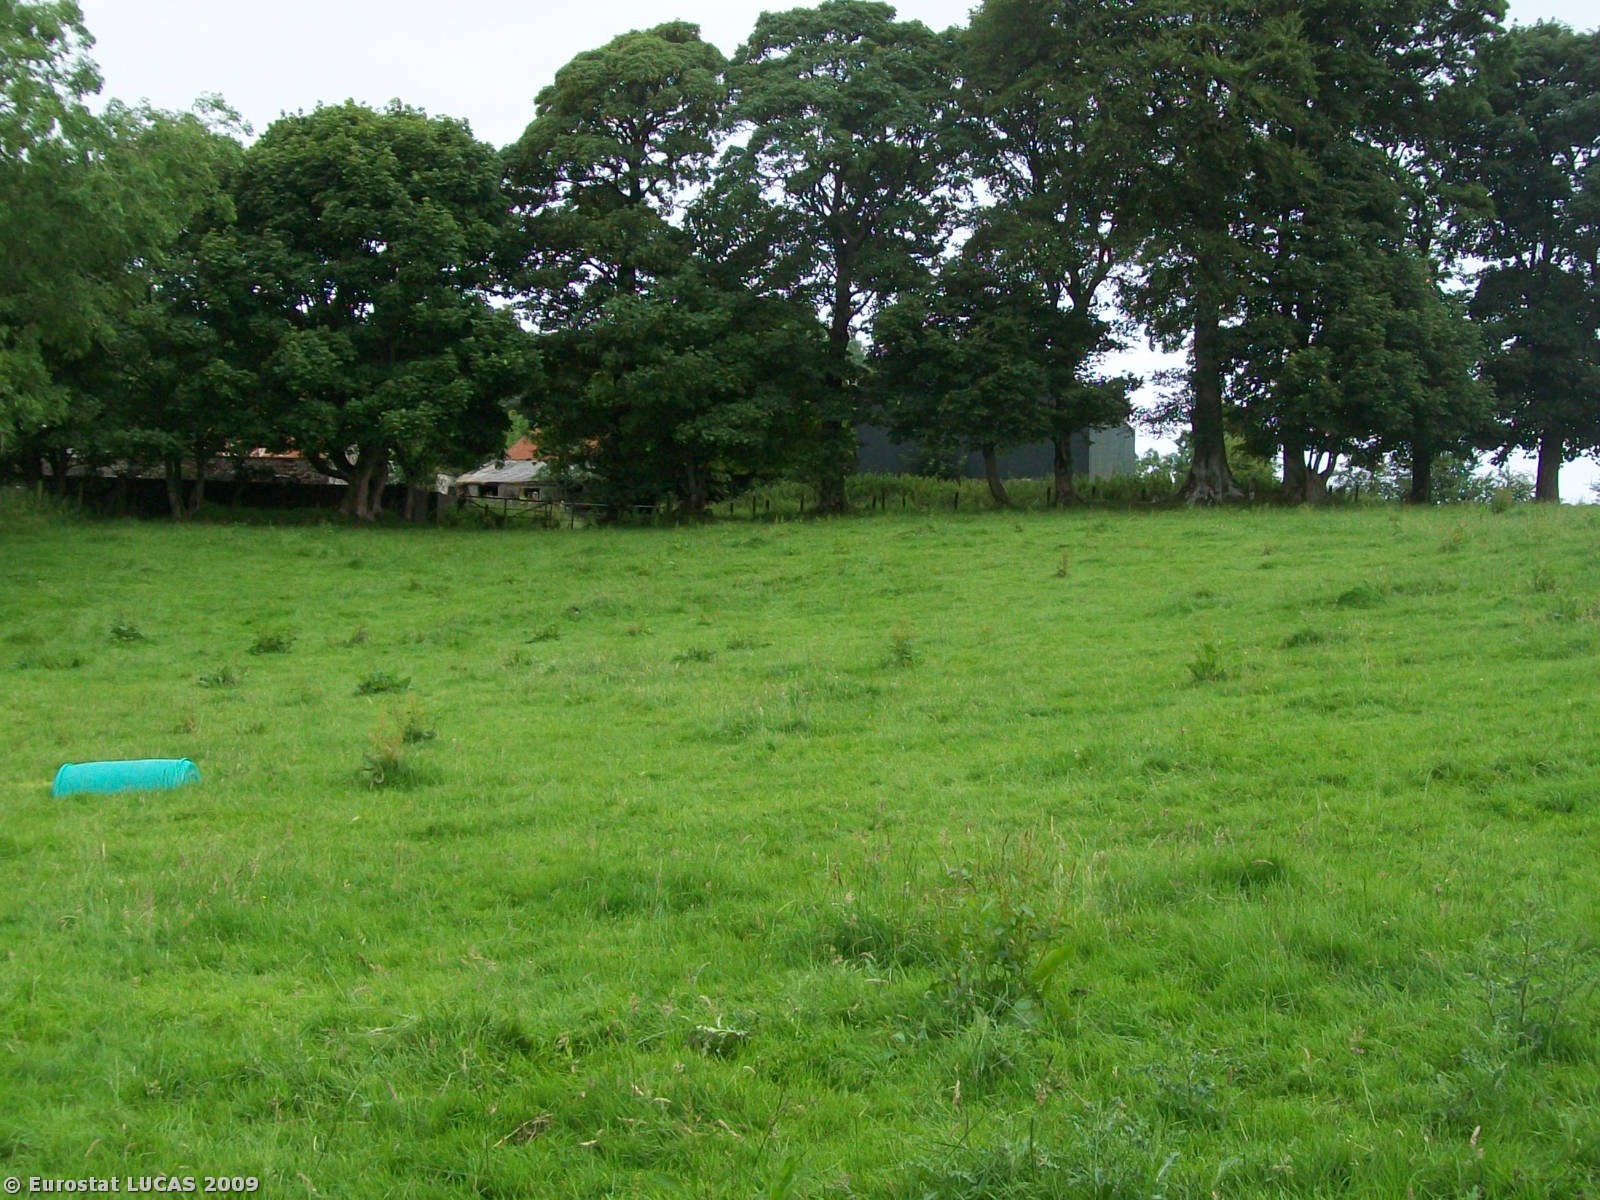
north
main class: Grassland
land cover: Grassland without tree/shrub cover
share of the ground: > 75 %
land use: Agriculture (excluding fallow land and kitchen gardens)
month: July
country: GB
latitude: 55.1712
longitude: -6.3028
